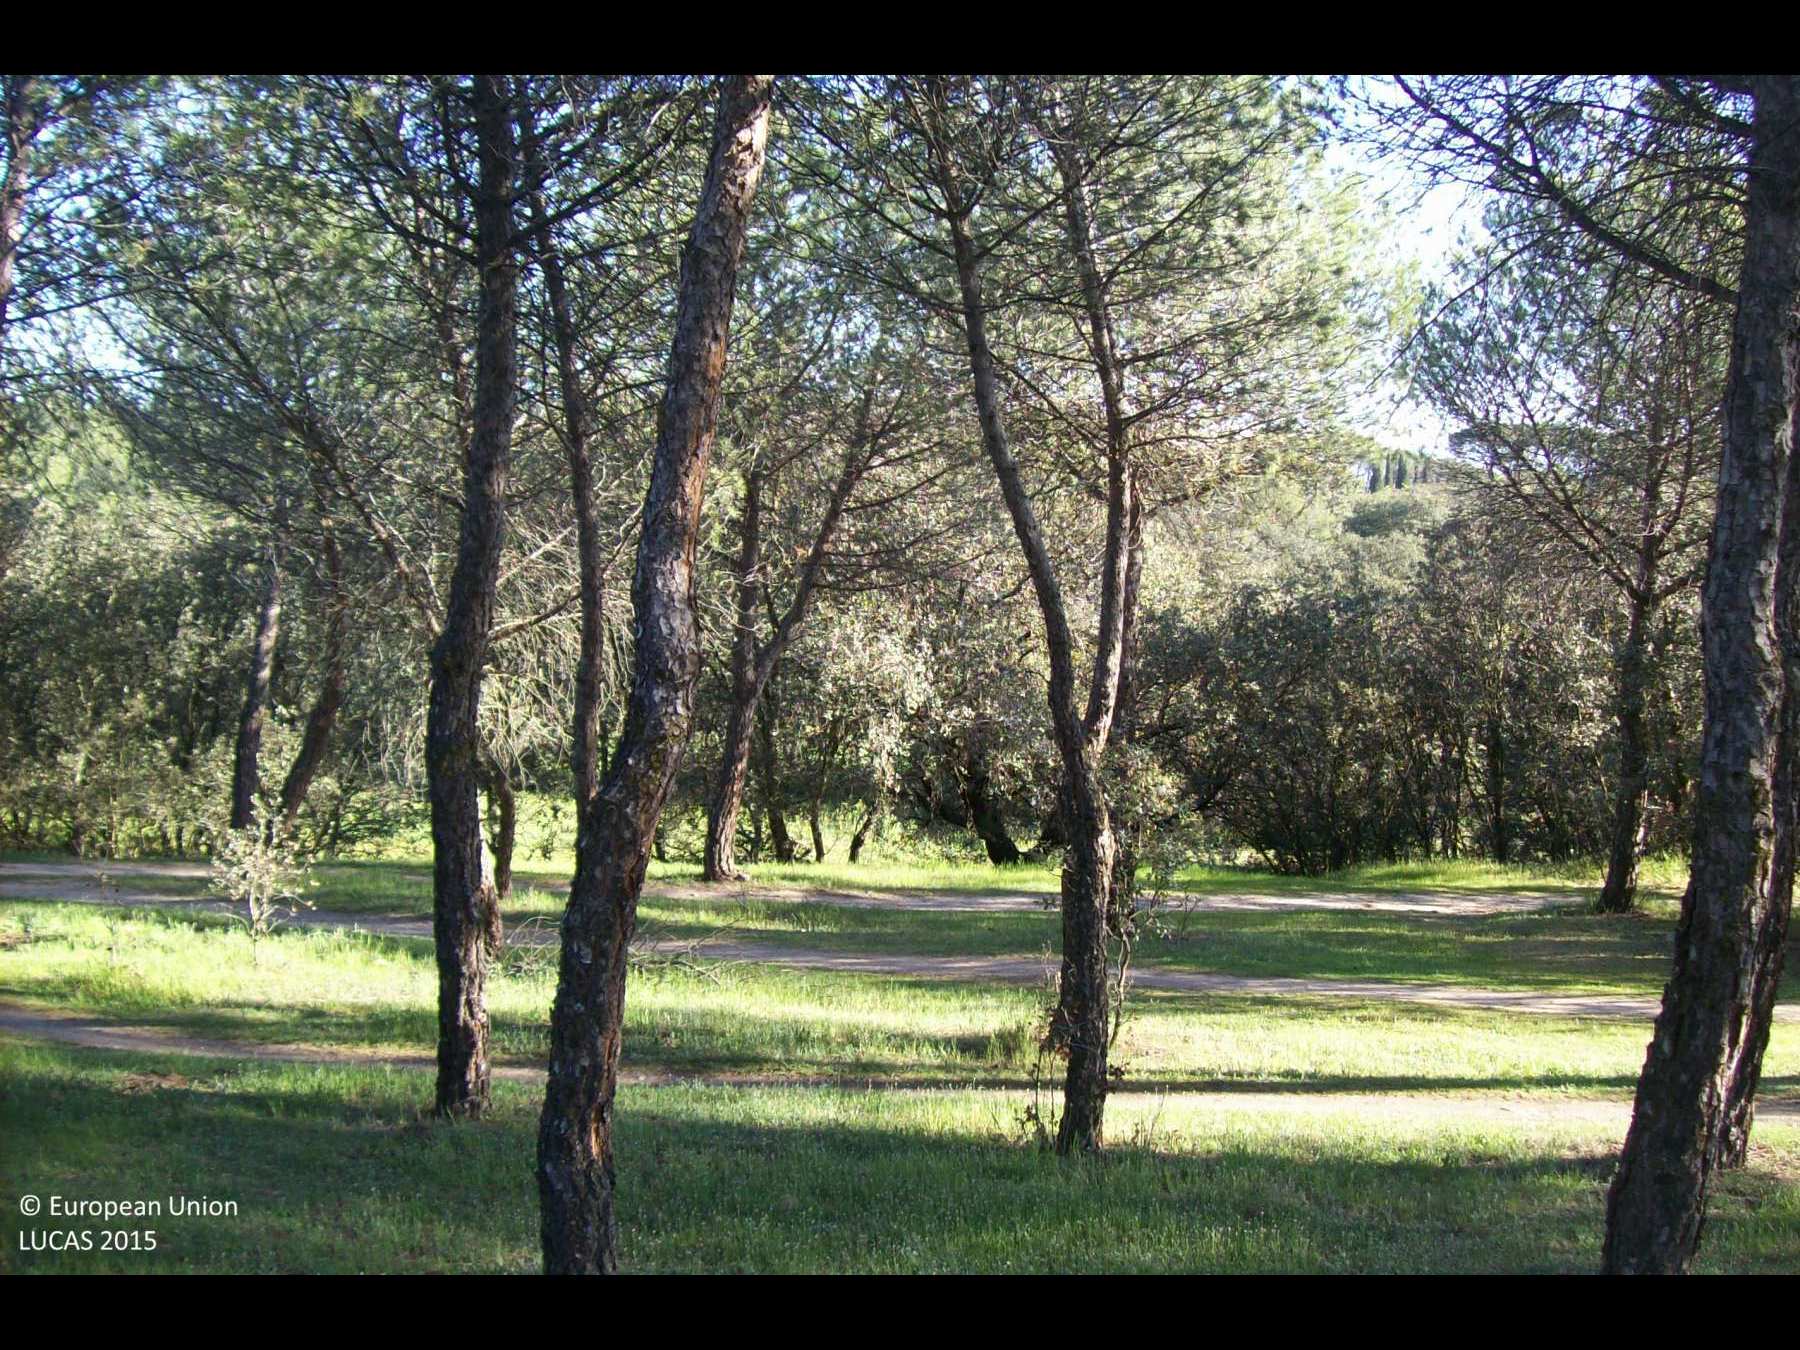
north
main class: Woodland
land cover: Pine dominated mixed woodland
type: coniferous forest of the mediterranean region
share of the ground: 50 - 75 %
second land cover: Grassland without tree/shrub cover
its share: > 75 %
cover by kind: coniferous forest trees 60 %, broadleaved forest trees 25 %, herbaceous plants 10 %
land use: Amenities, museums, leisure
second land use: Sport
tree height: < 5 m
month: April
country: ES
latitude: 40.4304
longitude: -3.7473
